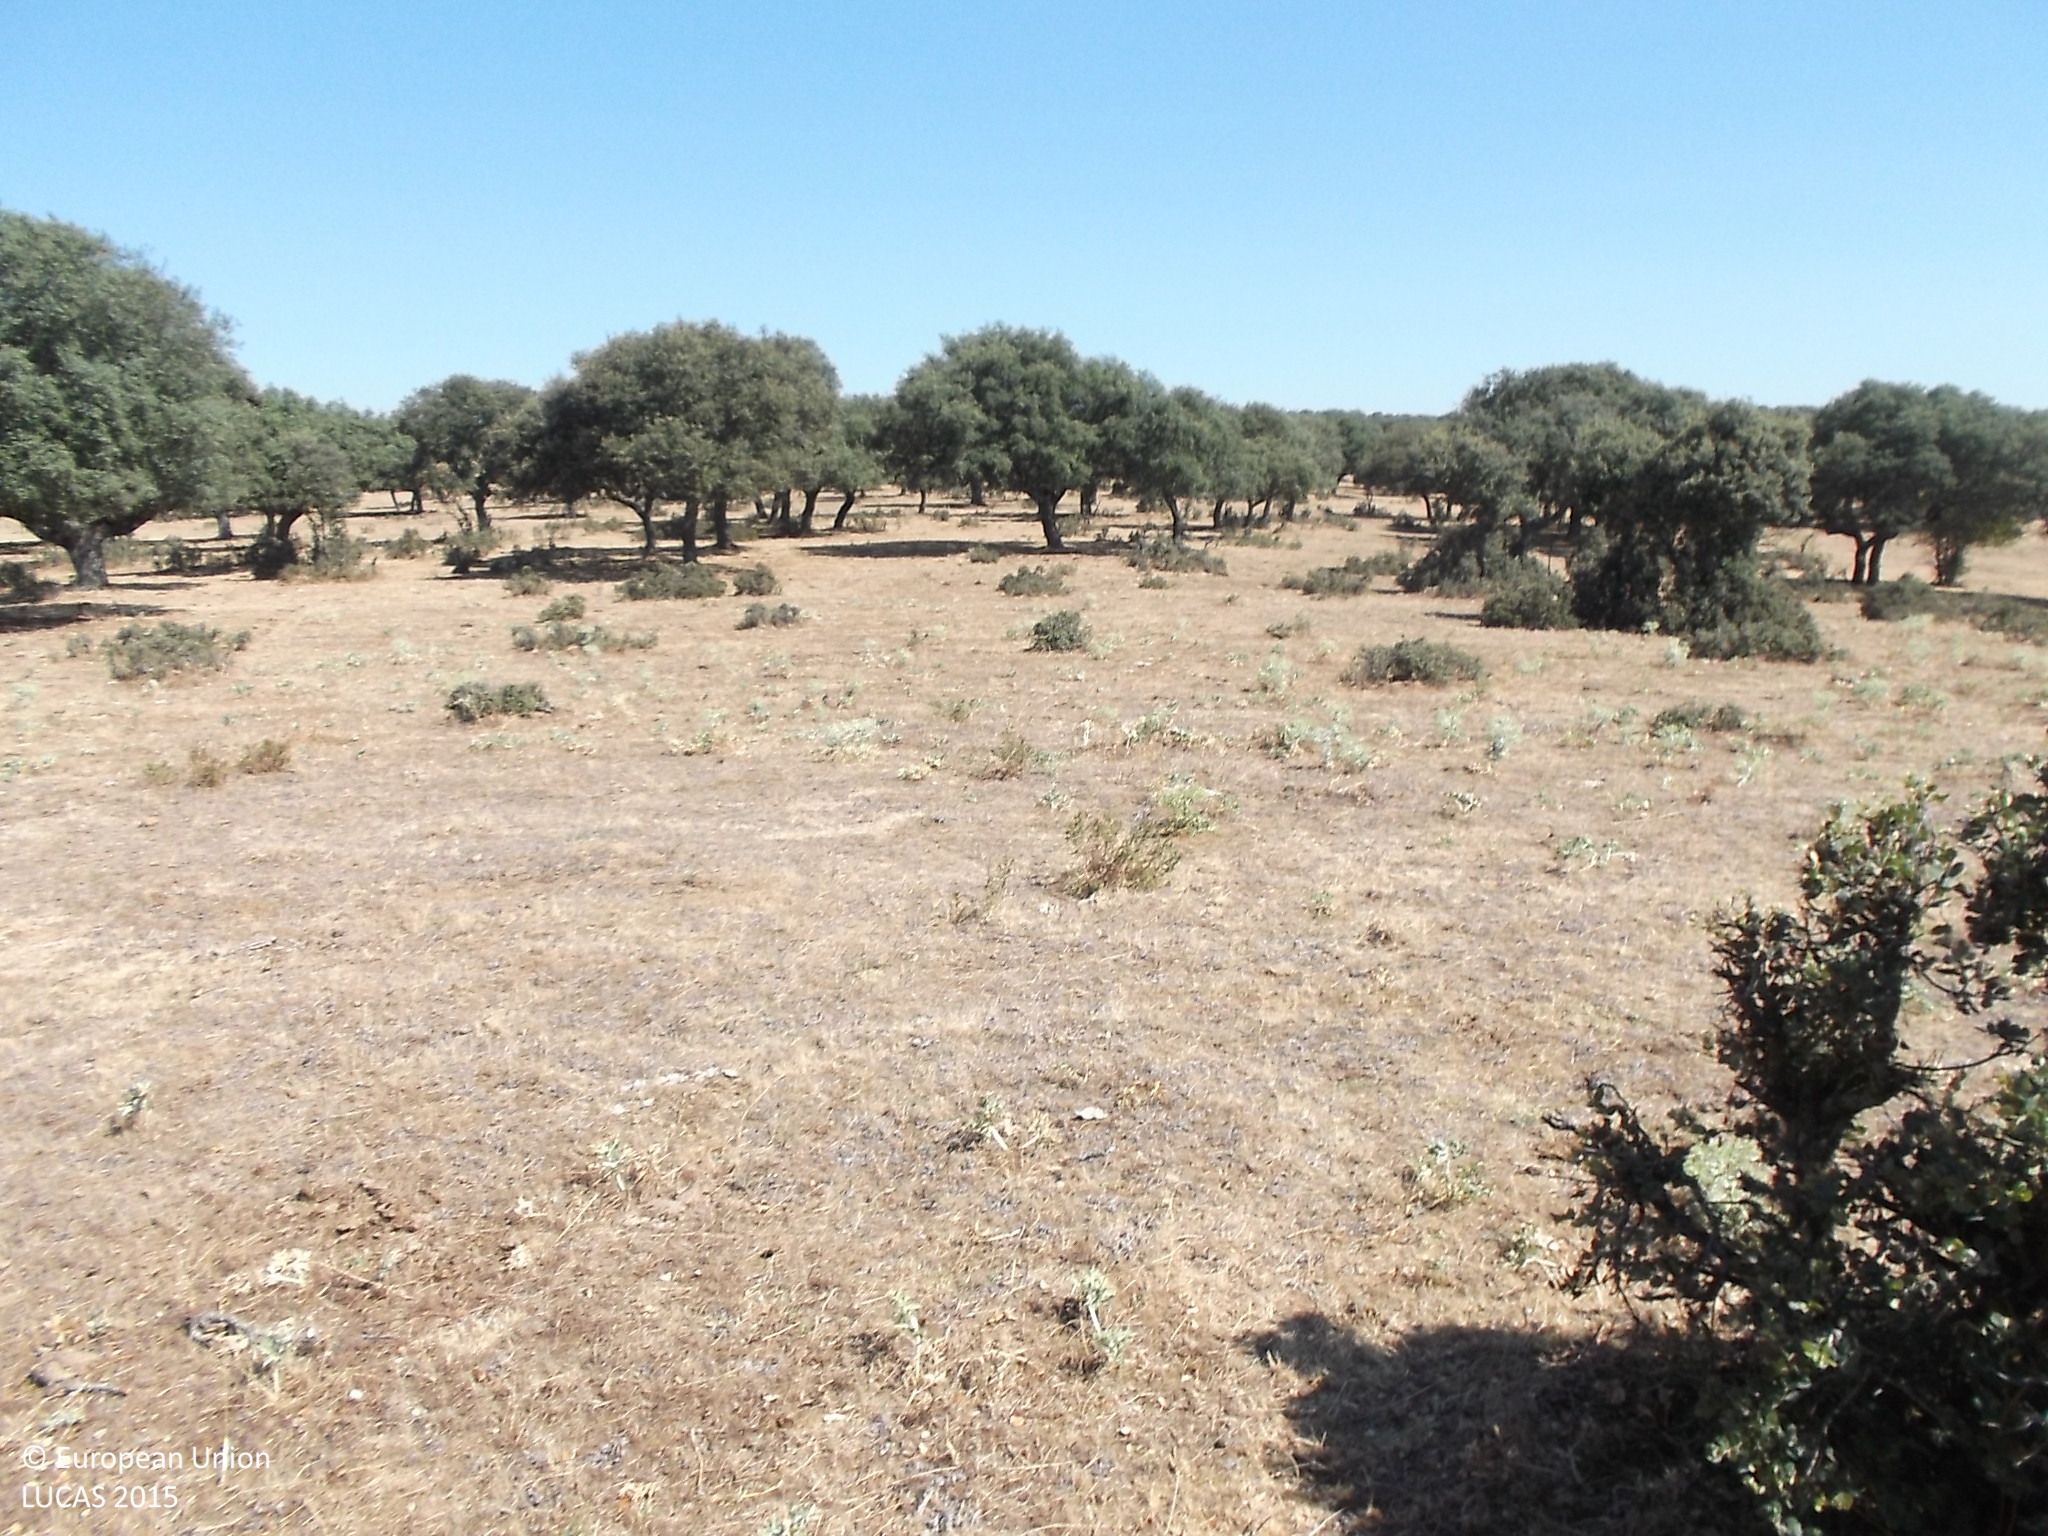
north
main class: Woodland
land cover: Broadleaved woodland
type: broadleaved evergreen forest
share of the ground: 25 - 50 %
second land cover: Shrubland without tree cover
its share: 50 - 75 %
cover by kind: herbaceous plants 40 %, broadleaved forest trees 30 %, shrubs 30 %
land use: Forestry
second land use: Agriculture (excluding fallow land and kitchen gardens)
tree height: < 5 m
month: July
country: ES
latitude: 41.1957
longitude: -5.9571
